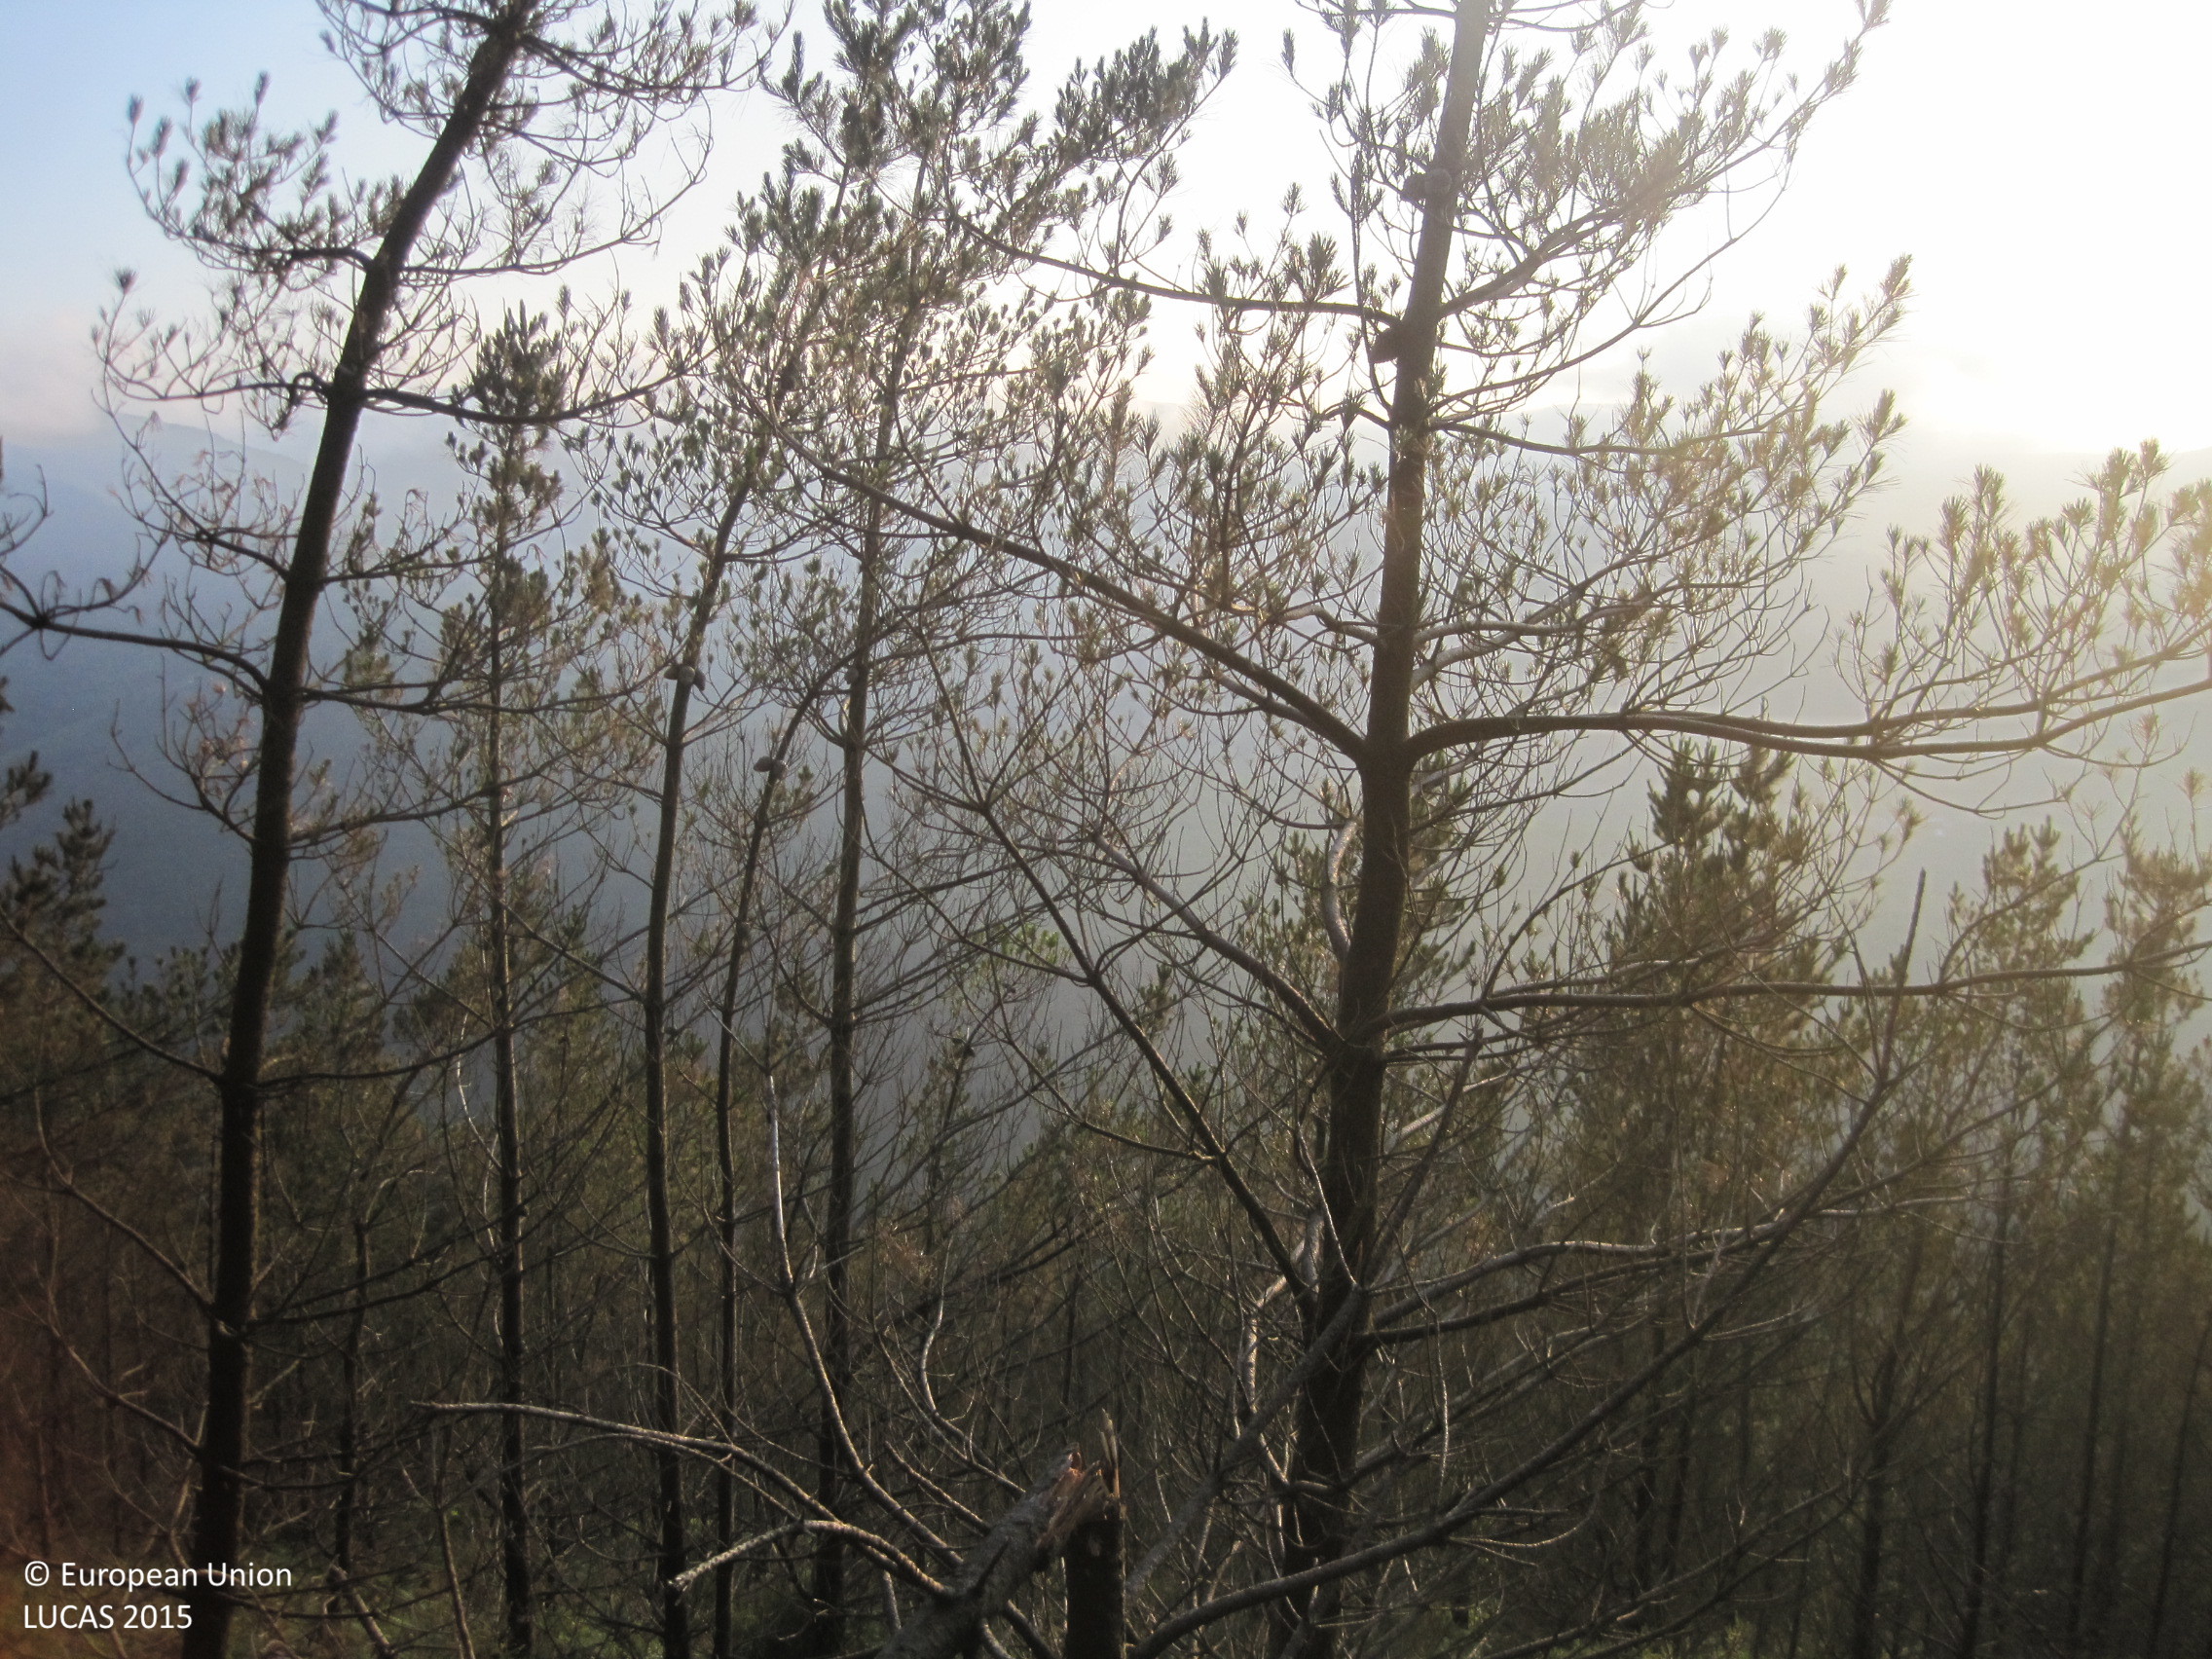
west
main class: Woodland
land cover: Pine dominated coniferous woodland
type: hemiboreal forest and nemoral coniferous forest and mixed broadleaved-coniferous forest
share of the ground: > 75 %
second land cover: Grassland without tree/shrub cover
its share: > 75 %
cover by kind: coniferous forest trees 90 %, shrubs 5 %, herbaceous plants 5 %
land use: Forestry
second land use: Agriculture (excluding fallow land and kitchen gardens)
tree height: > 5 m
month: June
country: ES
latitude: 43.1602
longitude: -1.8387
